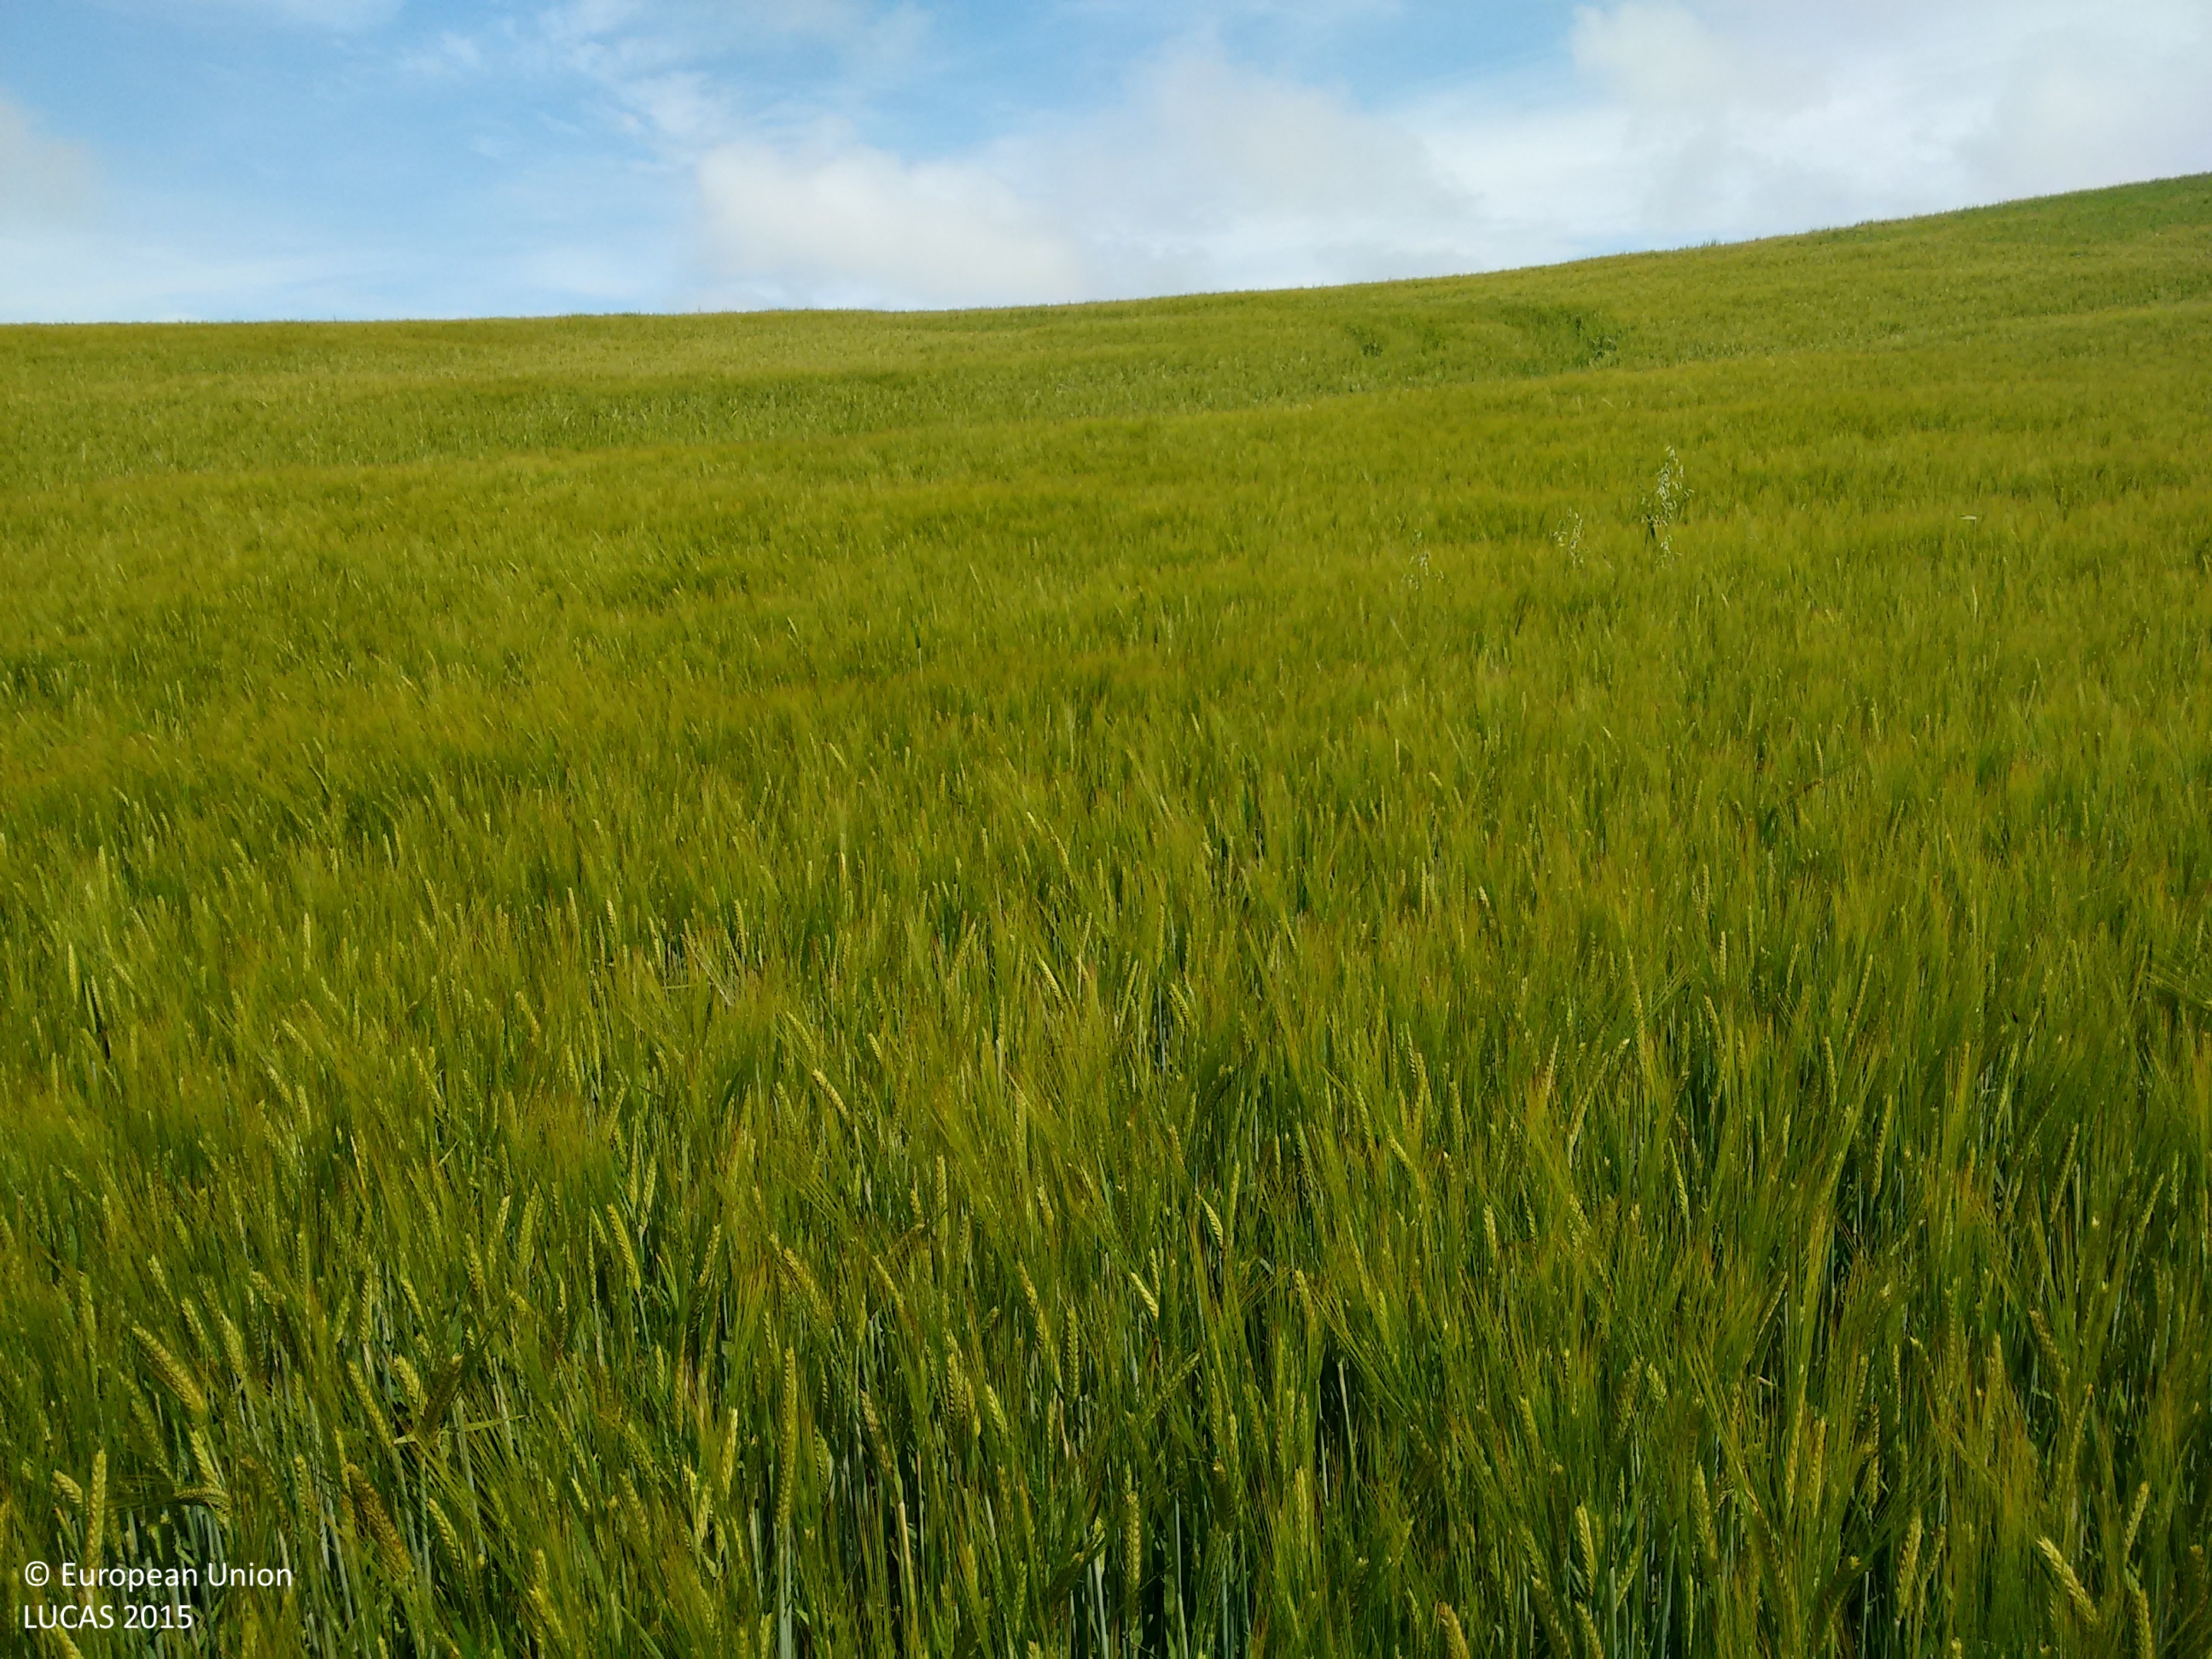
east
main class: Cropland
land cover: Barley
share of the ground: > 75 %
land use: Agriculture (excluding fallow land and kitchen gardens)
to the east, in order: Barley
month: July
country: GB
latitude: 56.0825
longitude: -3.2323
